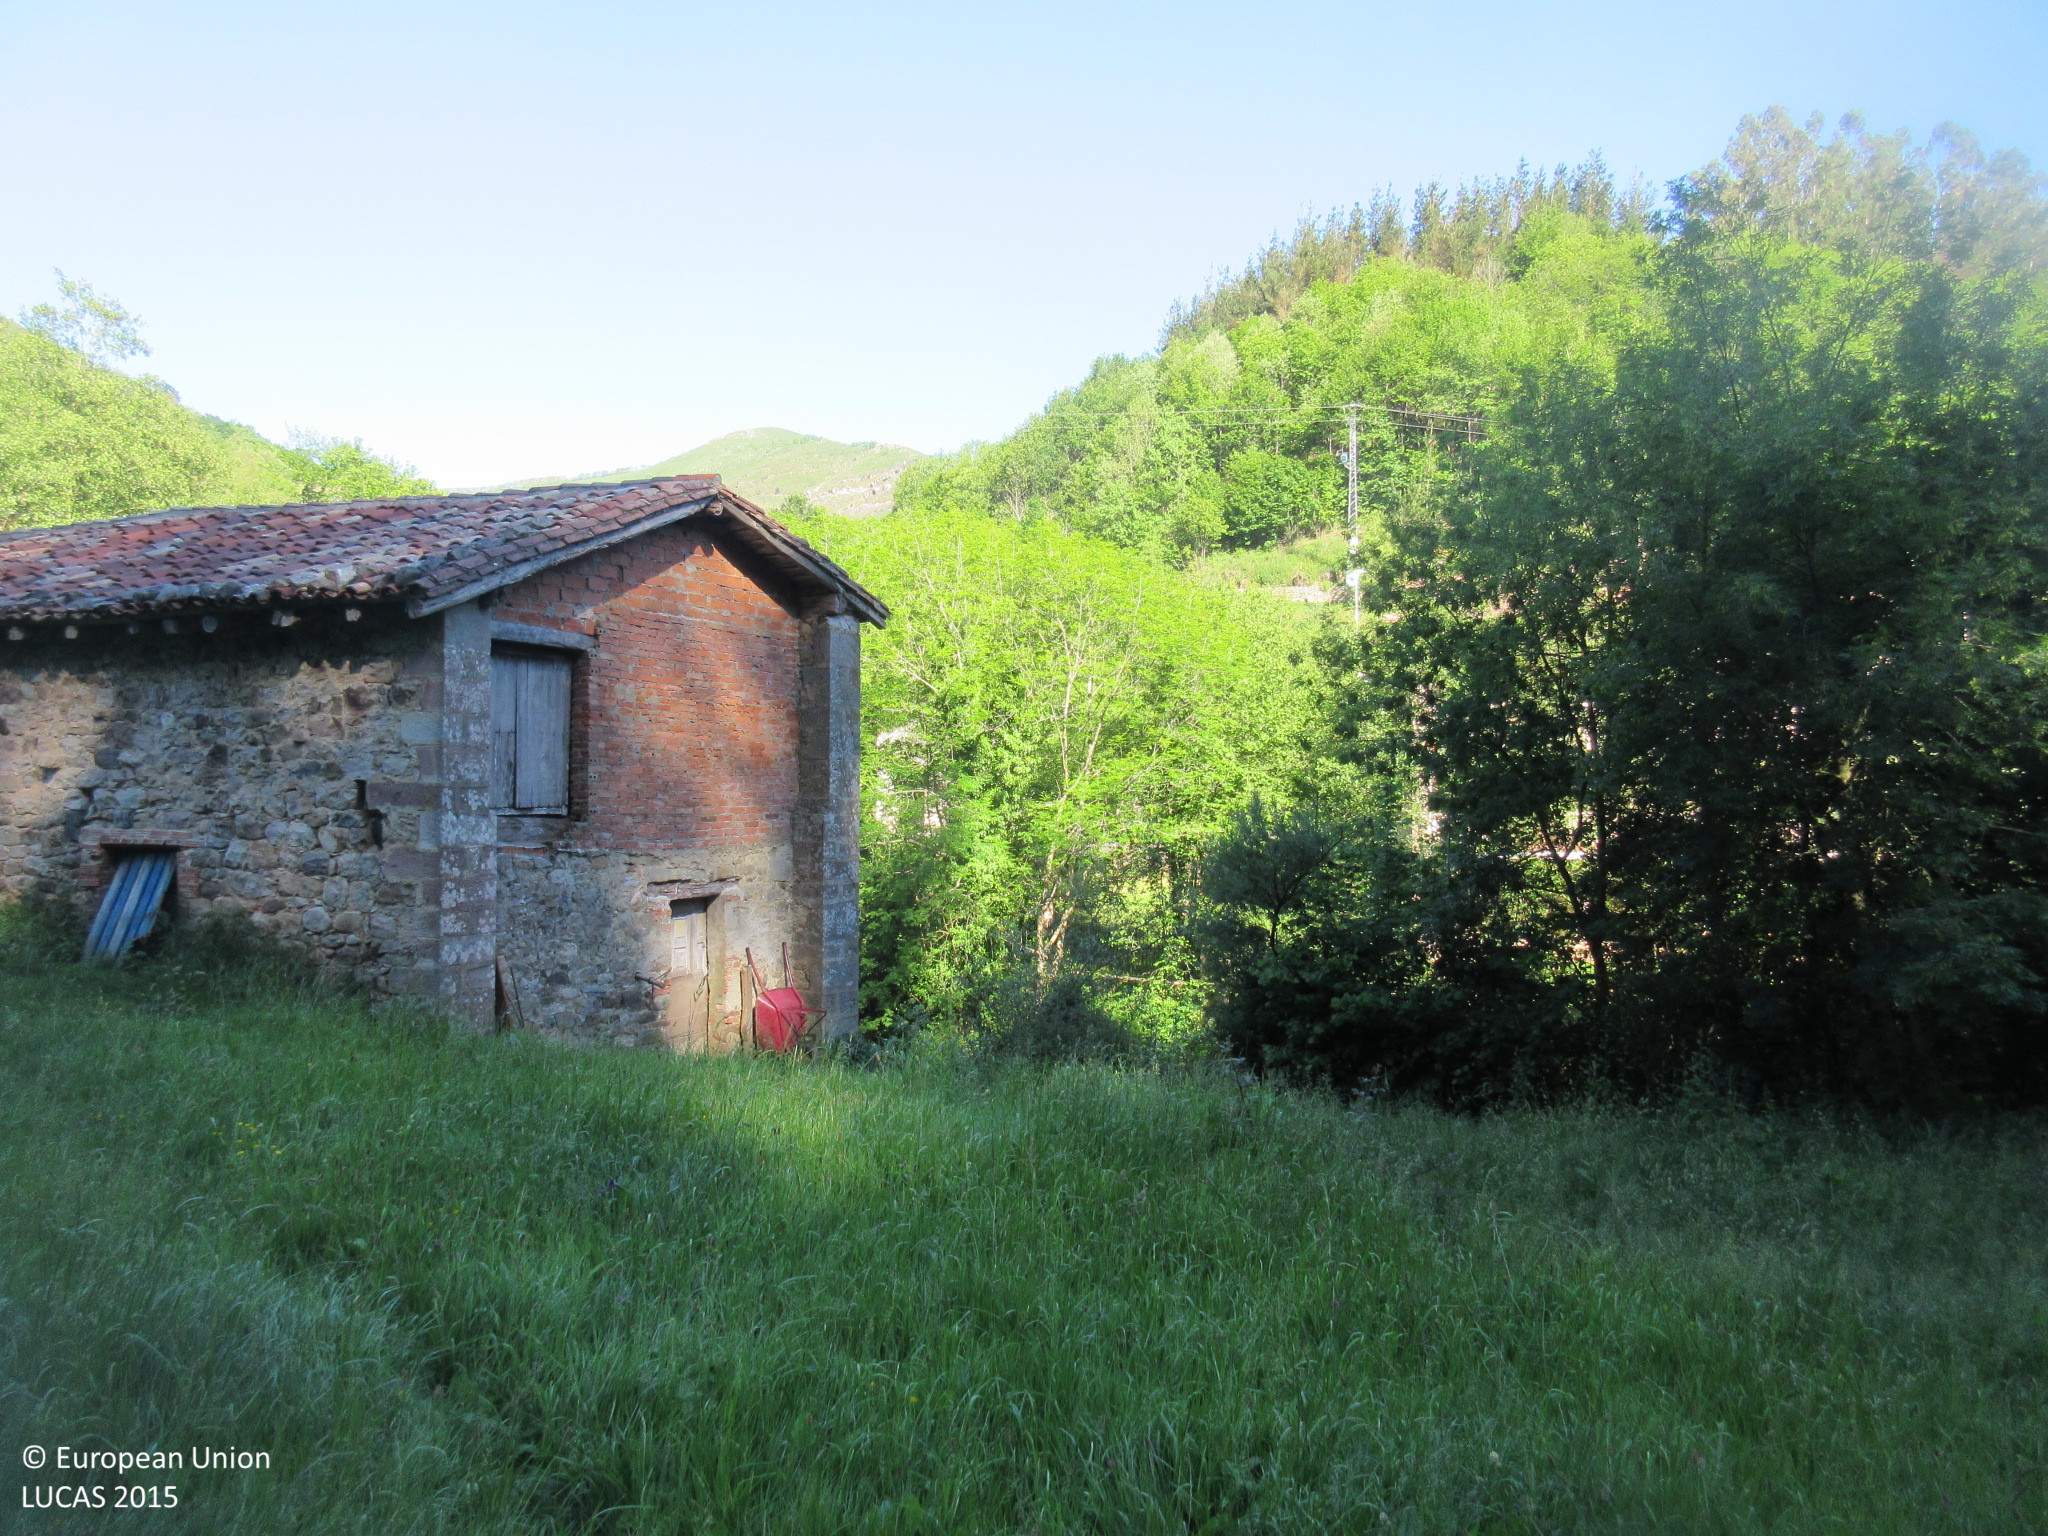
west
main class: Grassland
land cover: Grassland without tree/shrub cover
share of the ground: > 75 %
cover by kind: herbaceous plants 100 %
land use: Agriculture (excluding fallow land and kitchen gardens)
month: June
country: ES
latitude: 43.2300
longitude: -4.4015
